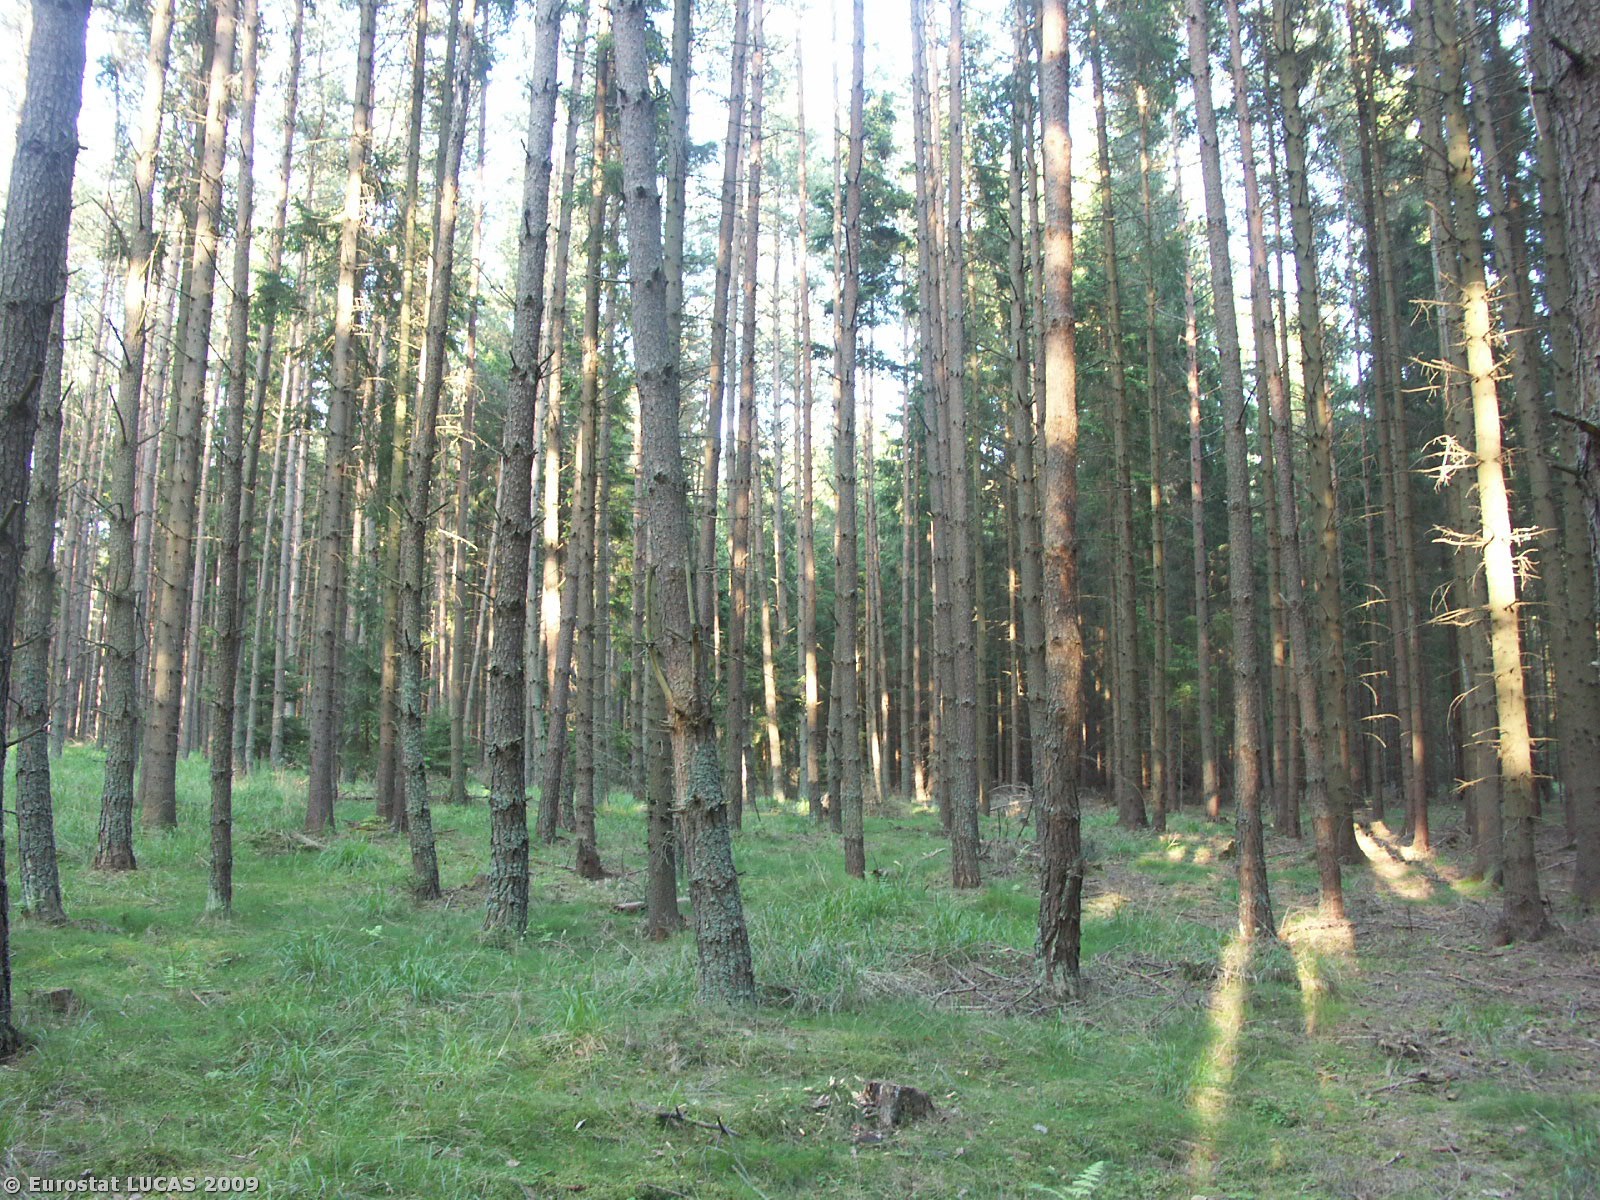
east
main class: Woodland
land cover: Coniferous woodland
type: hemiboreal forest and nemoral coniferous forest and mixed broadleaved-coniferous forest
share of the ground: > 75 %
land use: Forestry
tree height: > 5 m
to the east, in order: Coniferous woodland; Tracks; Coniferous woodland; Tracks; Coniferous woodland; Tracks; Coniferous woodland; Mixed woodland
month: May
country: CZ
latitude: 49.0492
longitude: 15.3528
